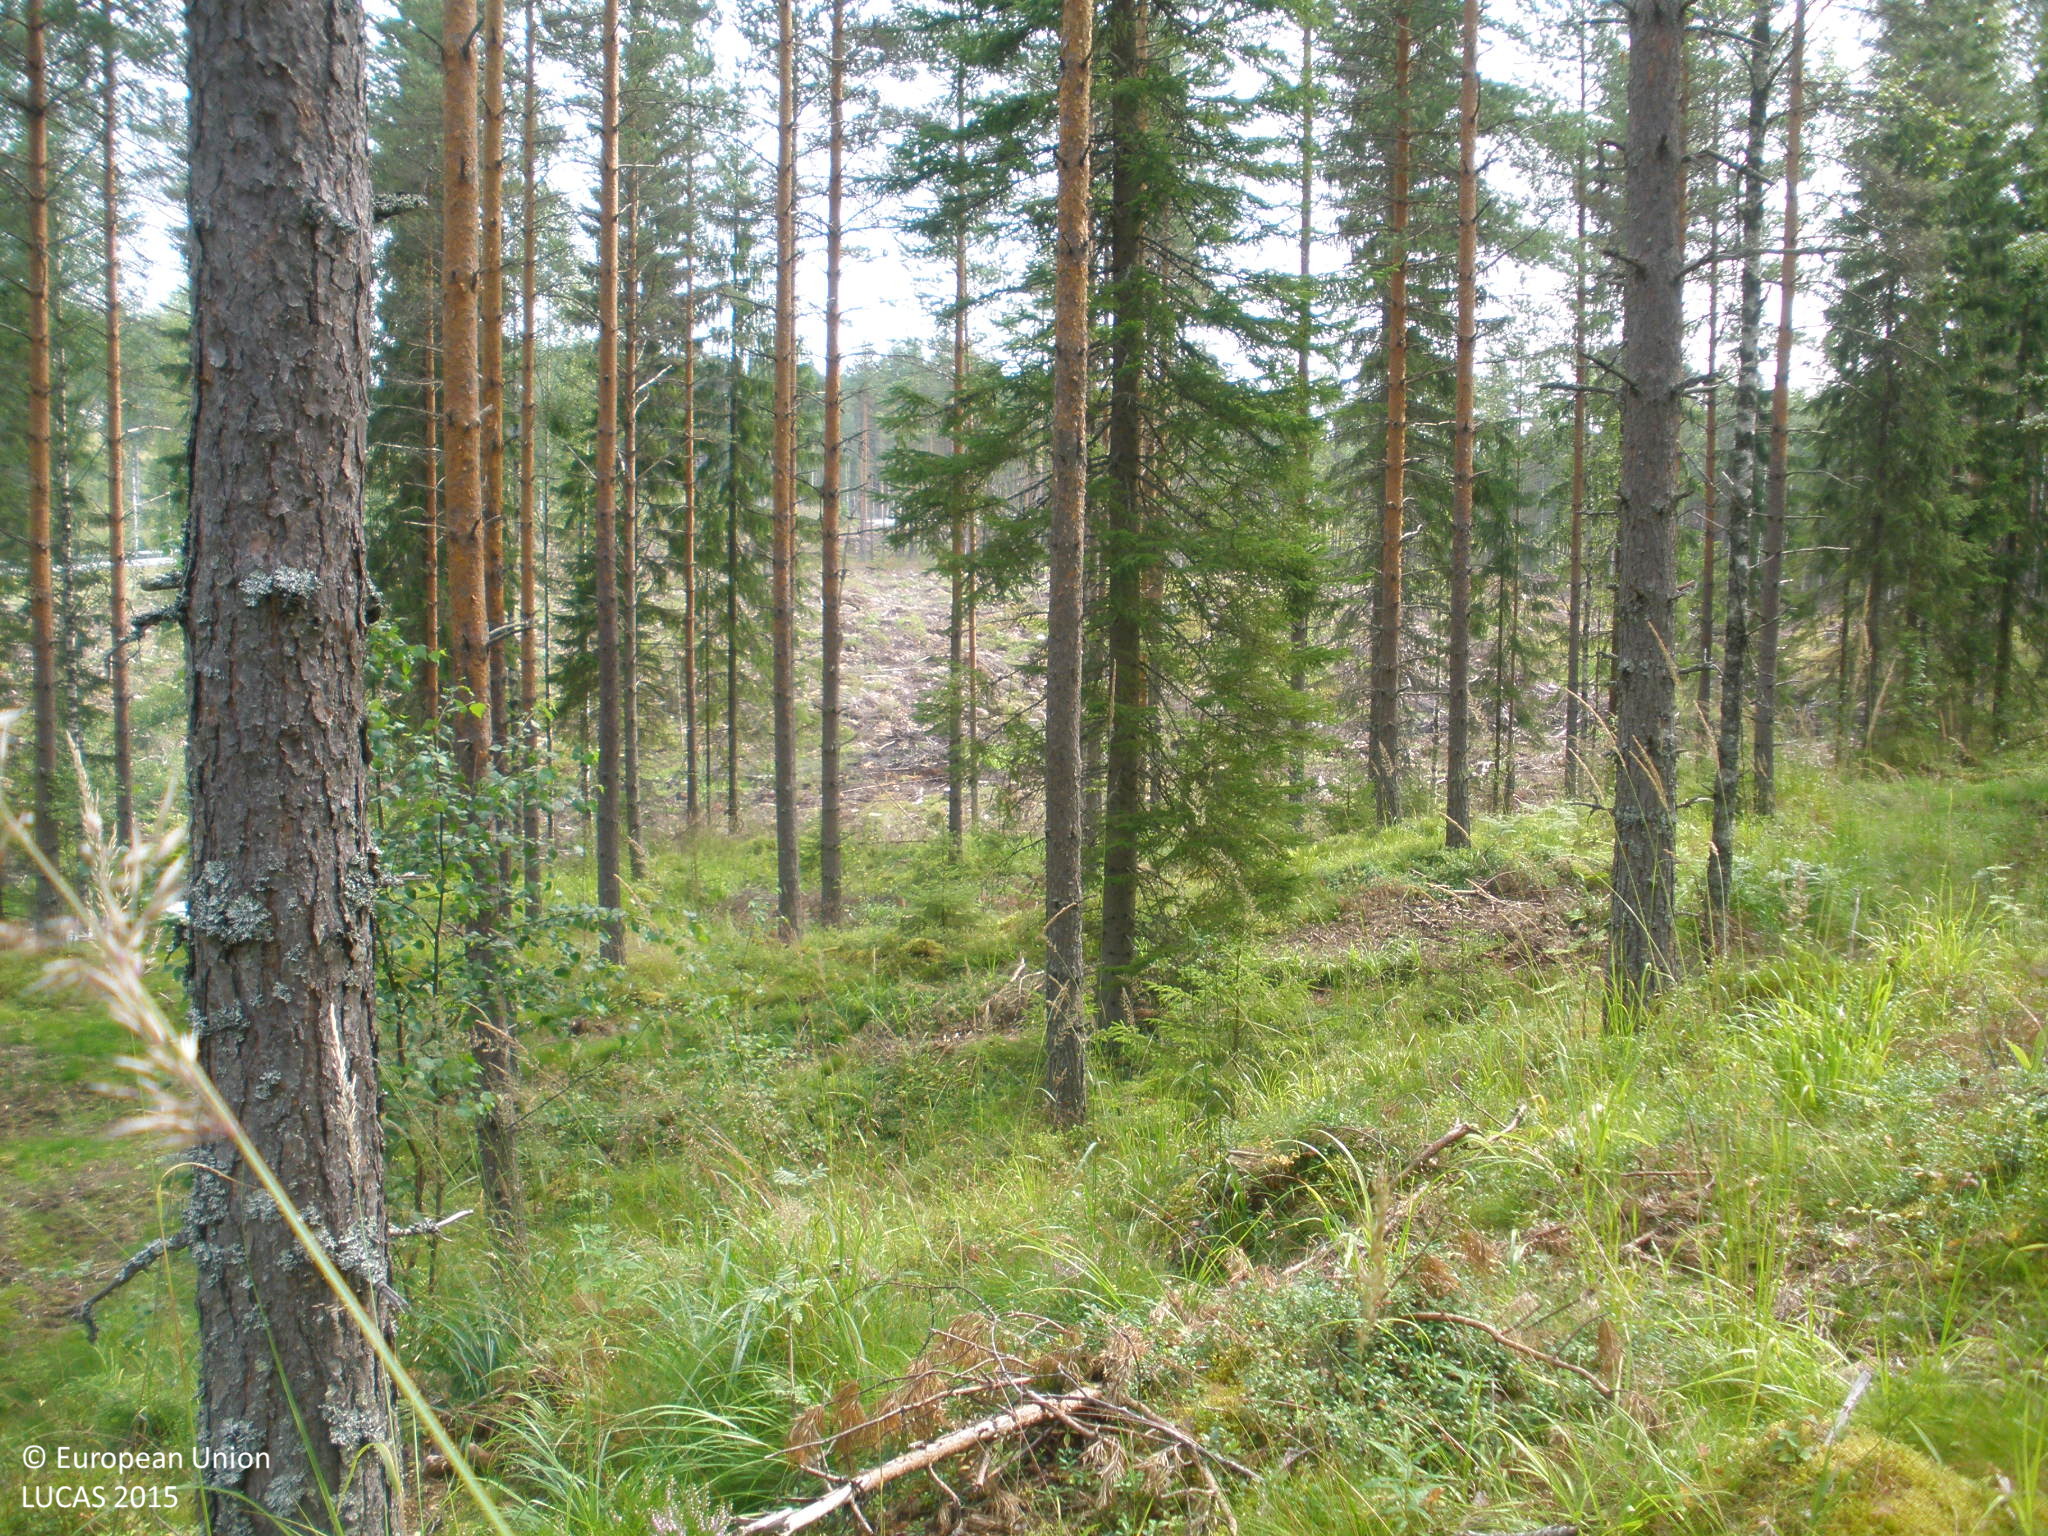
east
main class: Woodland
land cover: Pine dominated coniferous woodland
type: boreal forest
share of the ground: > 75 %
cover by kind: coniferous forest trees 75 %, herbaceous plants 10 %, lichens and mosses 10 %, shrubs 5 %
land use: Forestry
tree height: > 5 m
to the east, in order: Pine dominated coniferous woodland; Tracks; Pine dominated coniferous woodland; Tracks; Pine dominated coniferous woodland; Pine dominated mixed woodland; Other bare soil; Ditches and canals; Other bare soil; Pine dominated coniferous woodland
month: August
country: FI
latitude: 60.6107
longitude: 24.0343
